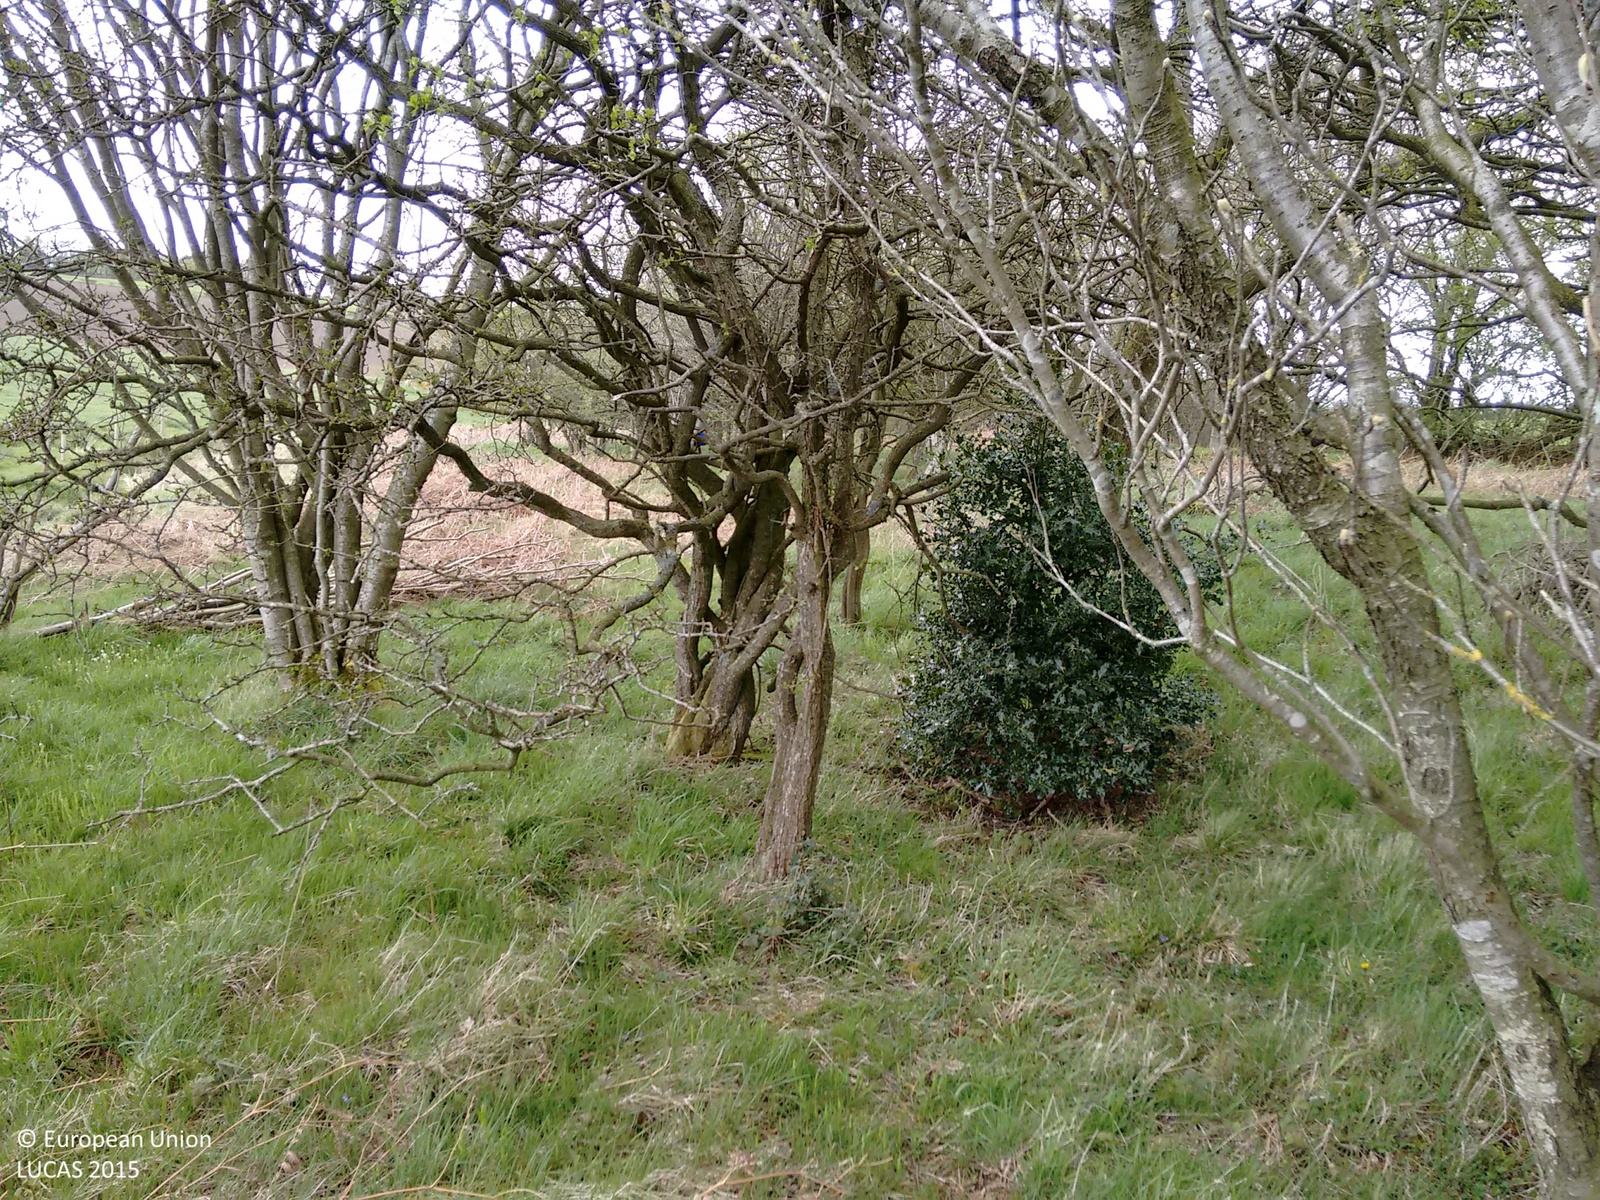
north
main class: Woodland
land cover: Broadleaved woodland
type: acidophilous oak and oak-birch forest
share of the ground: > 75 %
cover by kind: broadleaved forest trees 100 %
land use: Semi-natural and natural areas not in use
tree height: > 5 m
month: May
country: GB
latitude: 54.9077
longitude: -2.0498
